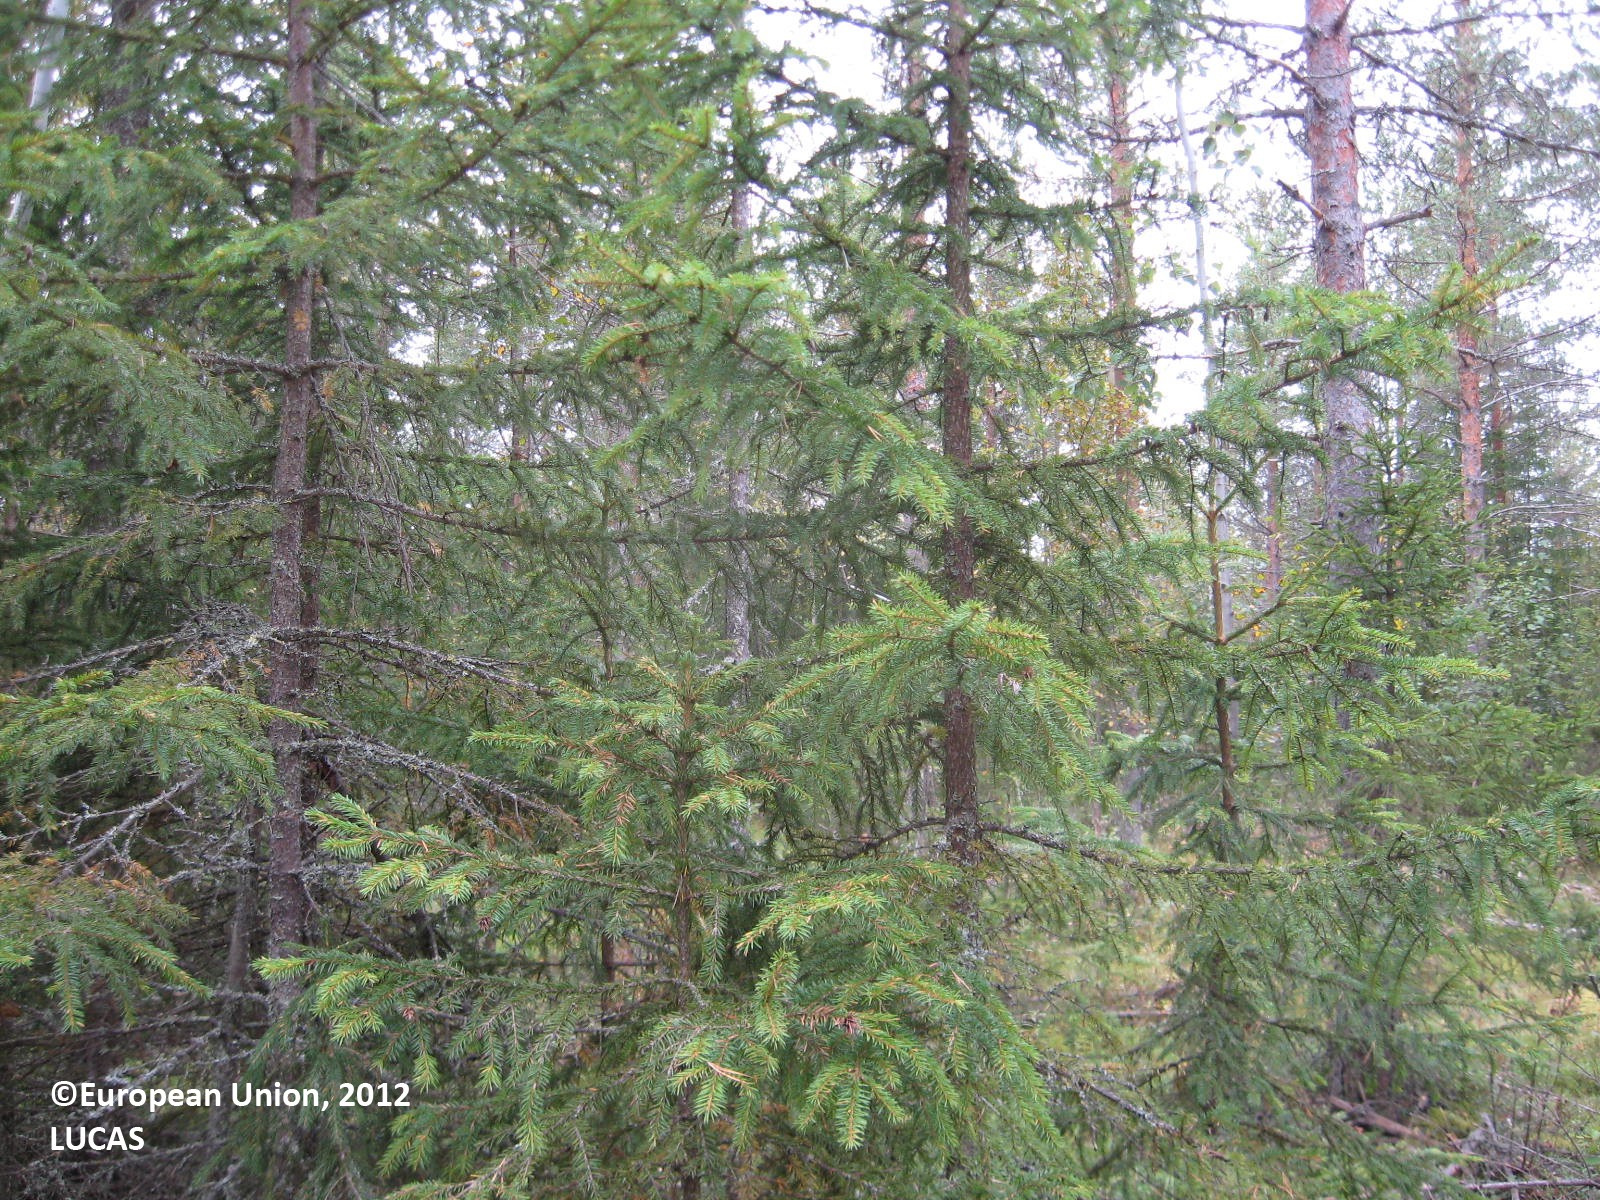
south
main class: Woodland
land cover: Pine dominated coniferous woodland
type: boreal forest
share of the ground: > 75 %
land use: Forestry
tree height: > 5 m
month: September
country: FI
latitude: 64.0196
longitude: 28.3670
